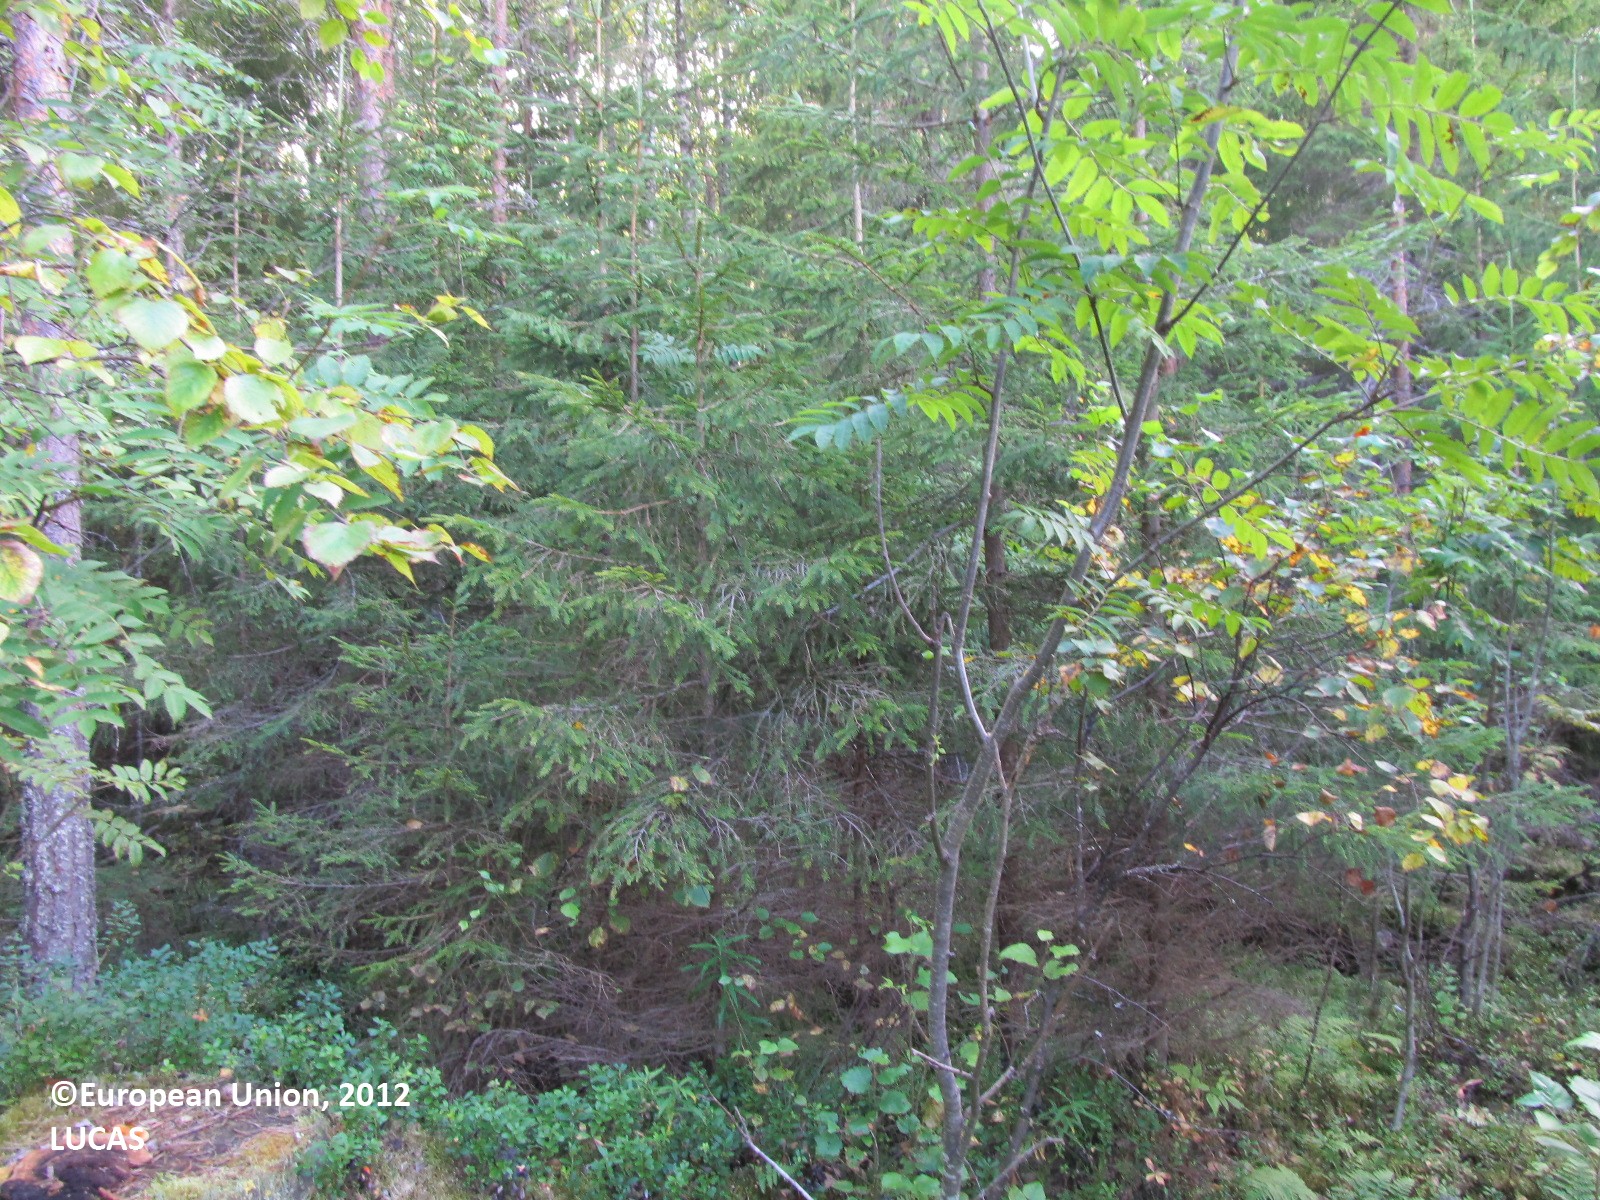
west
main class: Woodland
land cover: Pine dominated mixed woodland
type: boreal forest
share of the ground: 50 - 75 %
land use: Forestry
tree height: > 5 m
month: August
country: FI
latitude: 61.9887
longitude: 27.6022
